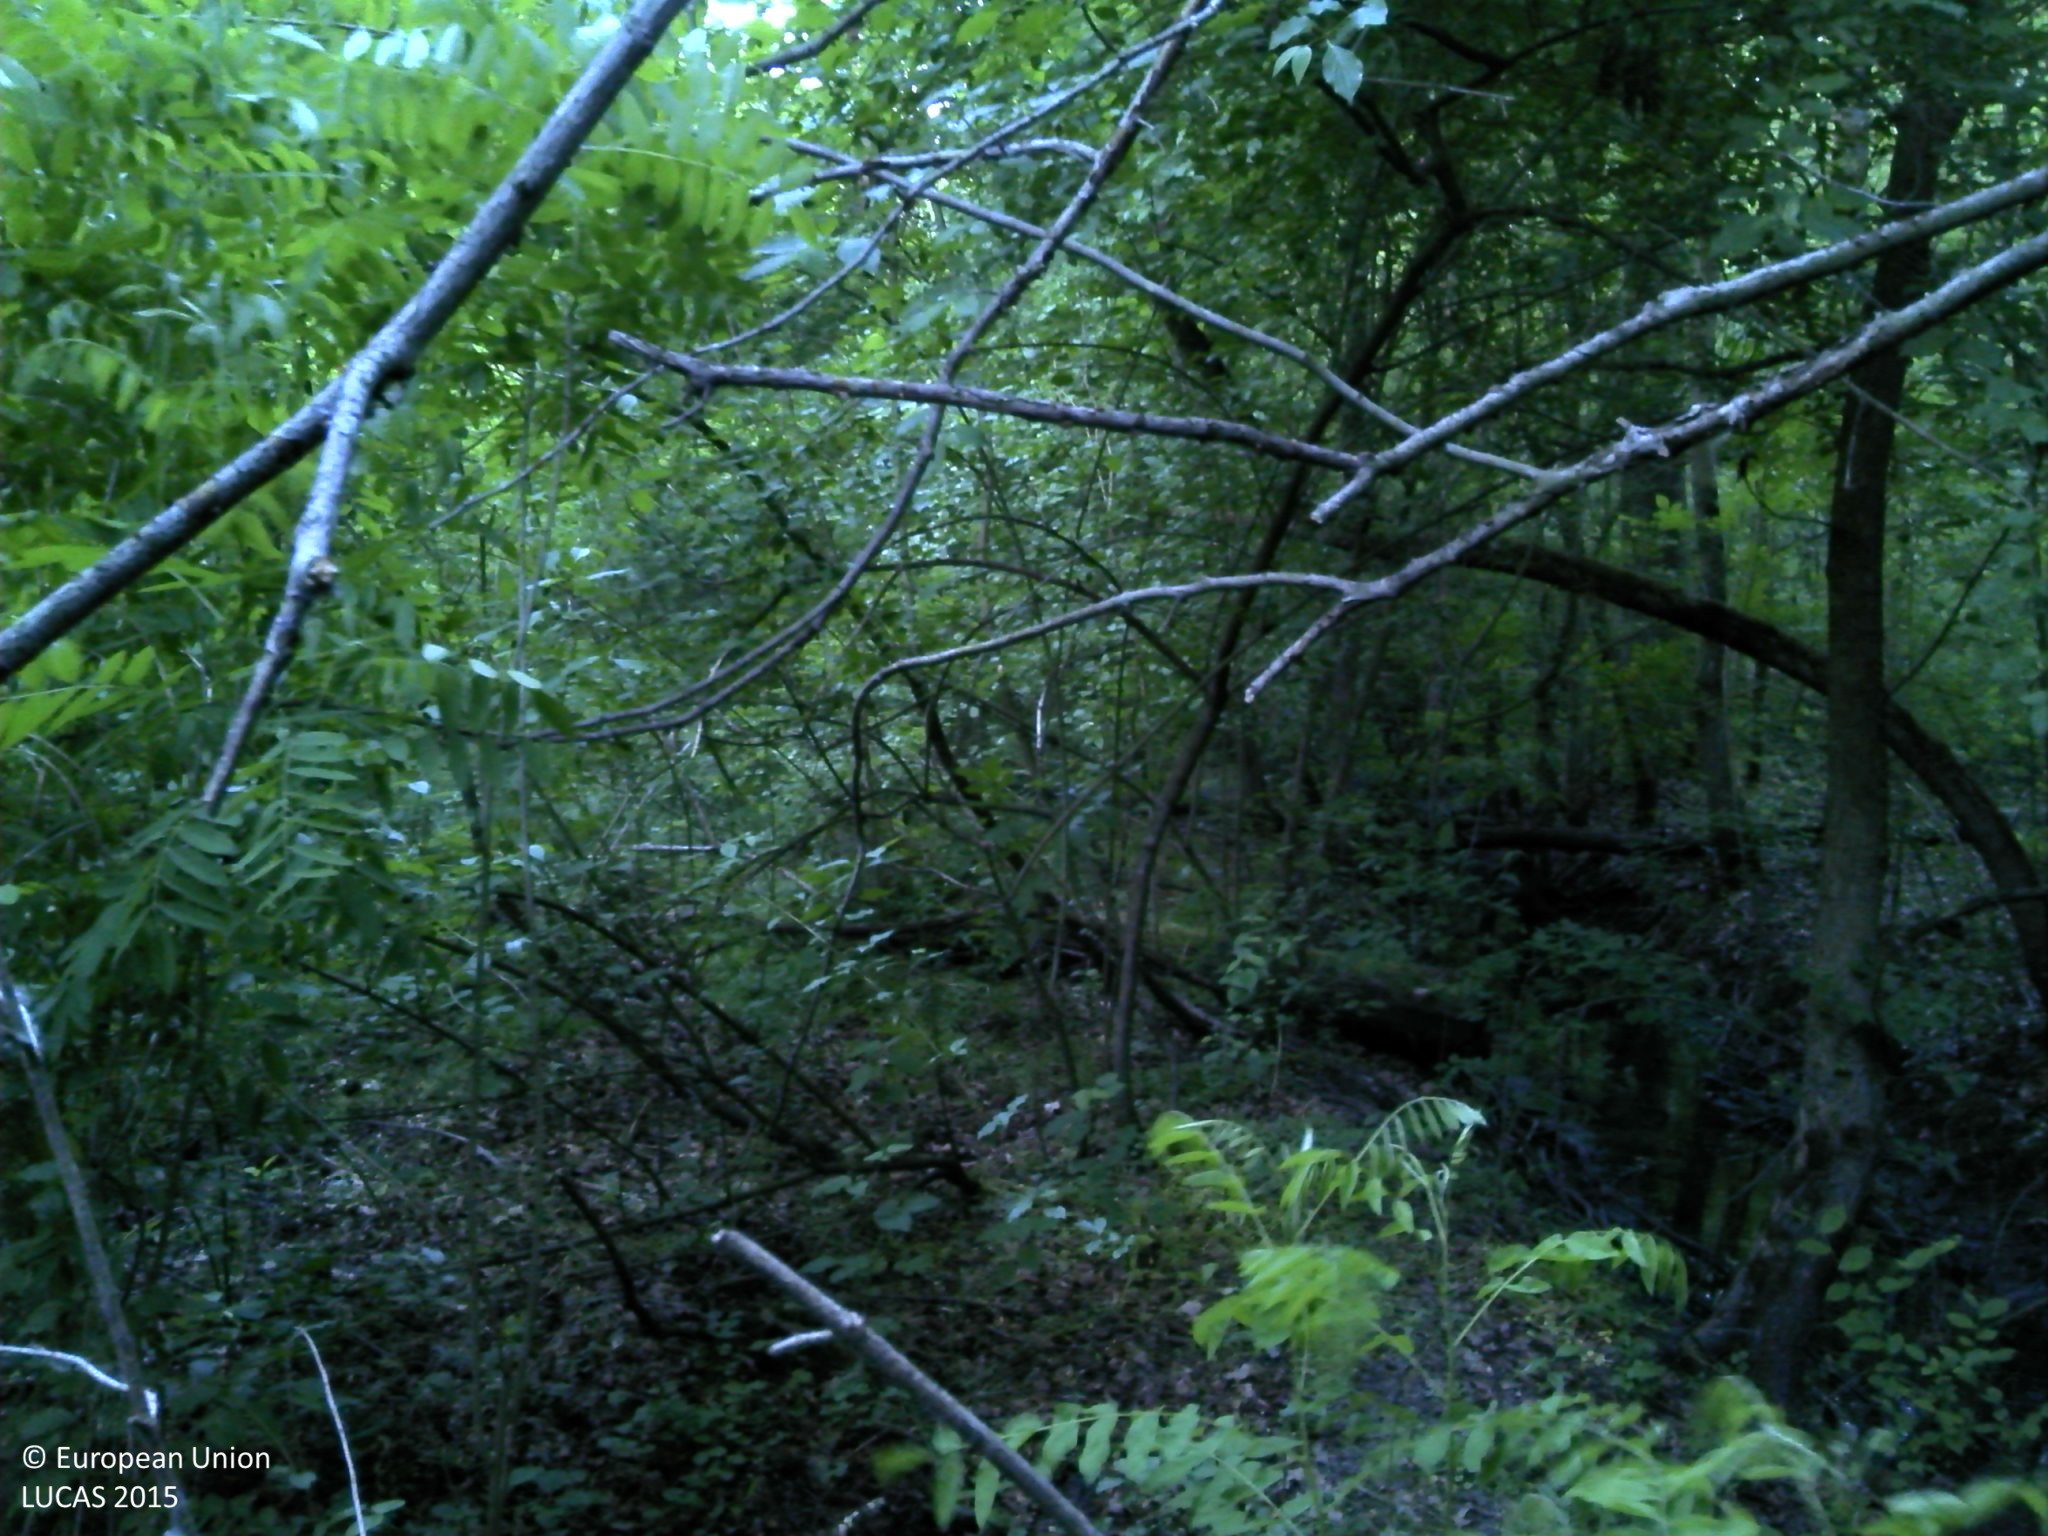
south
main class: Woodland
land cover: Broadleaved woodland
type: acidophilous oak and oak-birch forest
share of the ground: > 75 %
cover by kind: broadleaved forest trees 90 %, shrubs 10 %
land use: Forestry
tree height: > 5 m
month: May
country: HR
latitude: 45.1127
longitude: 18.8662
